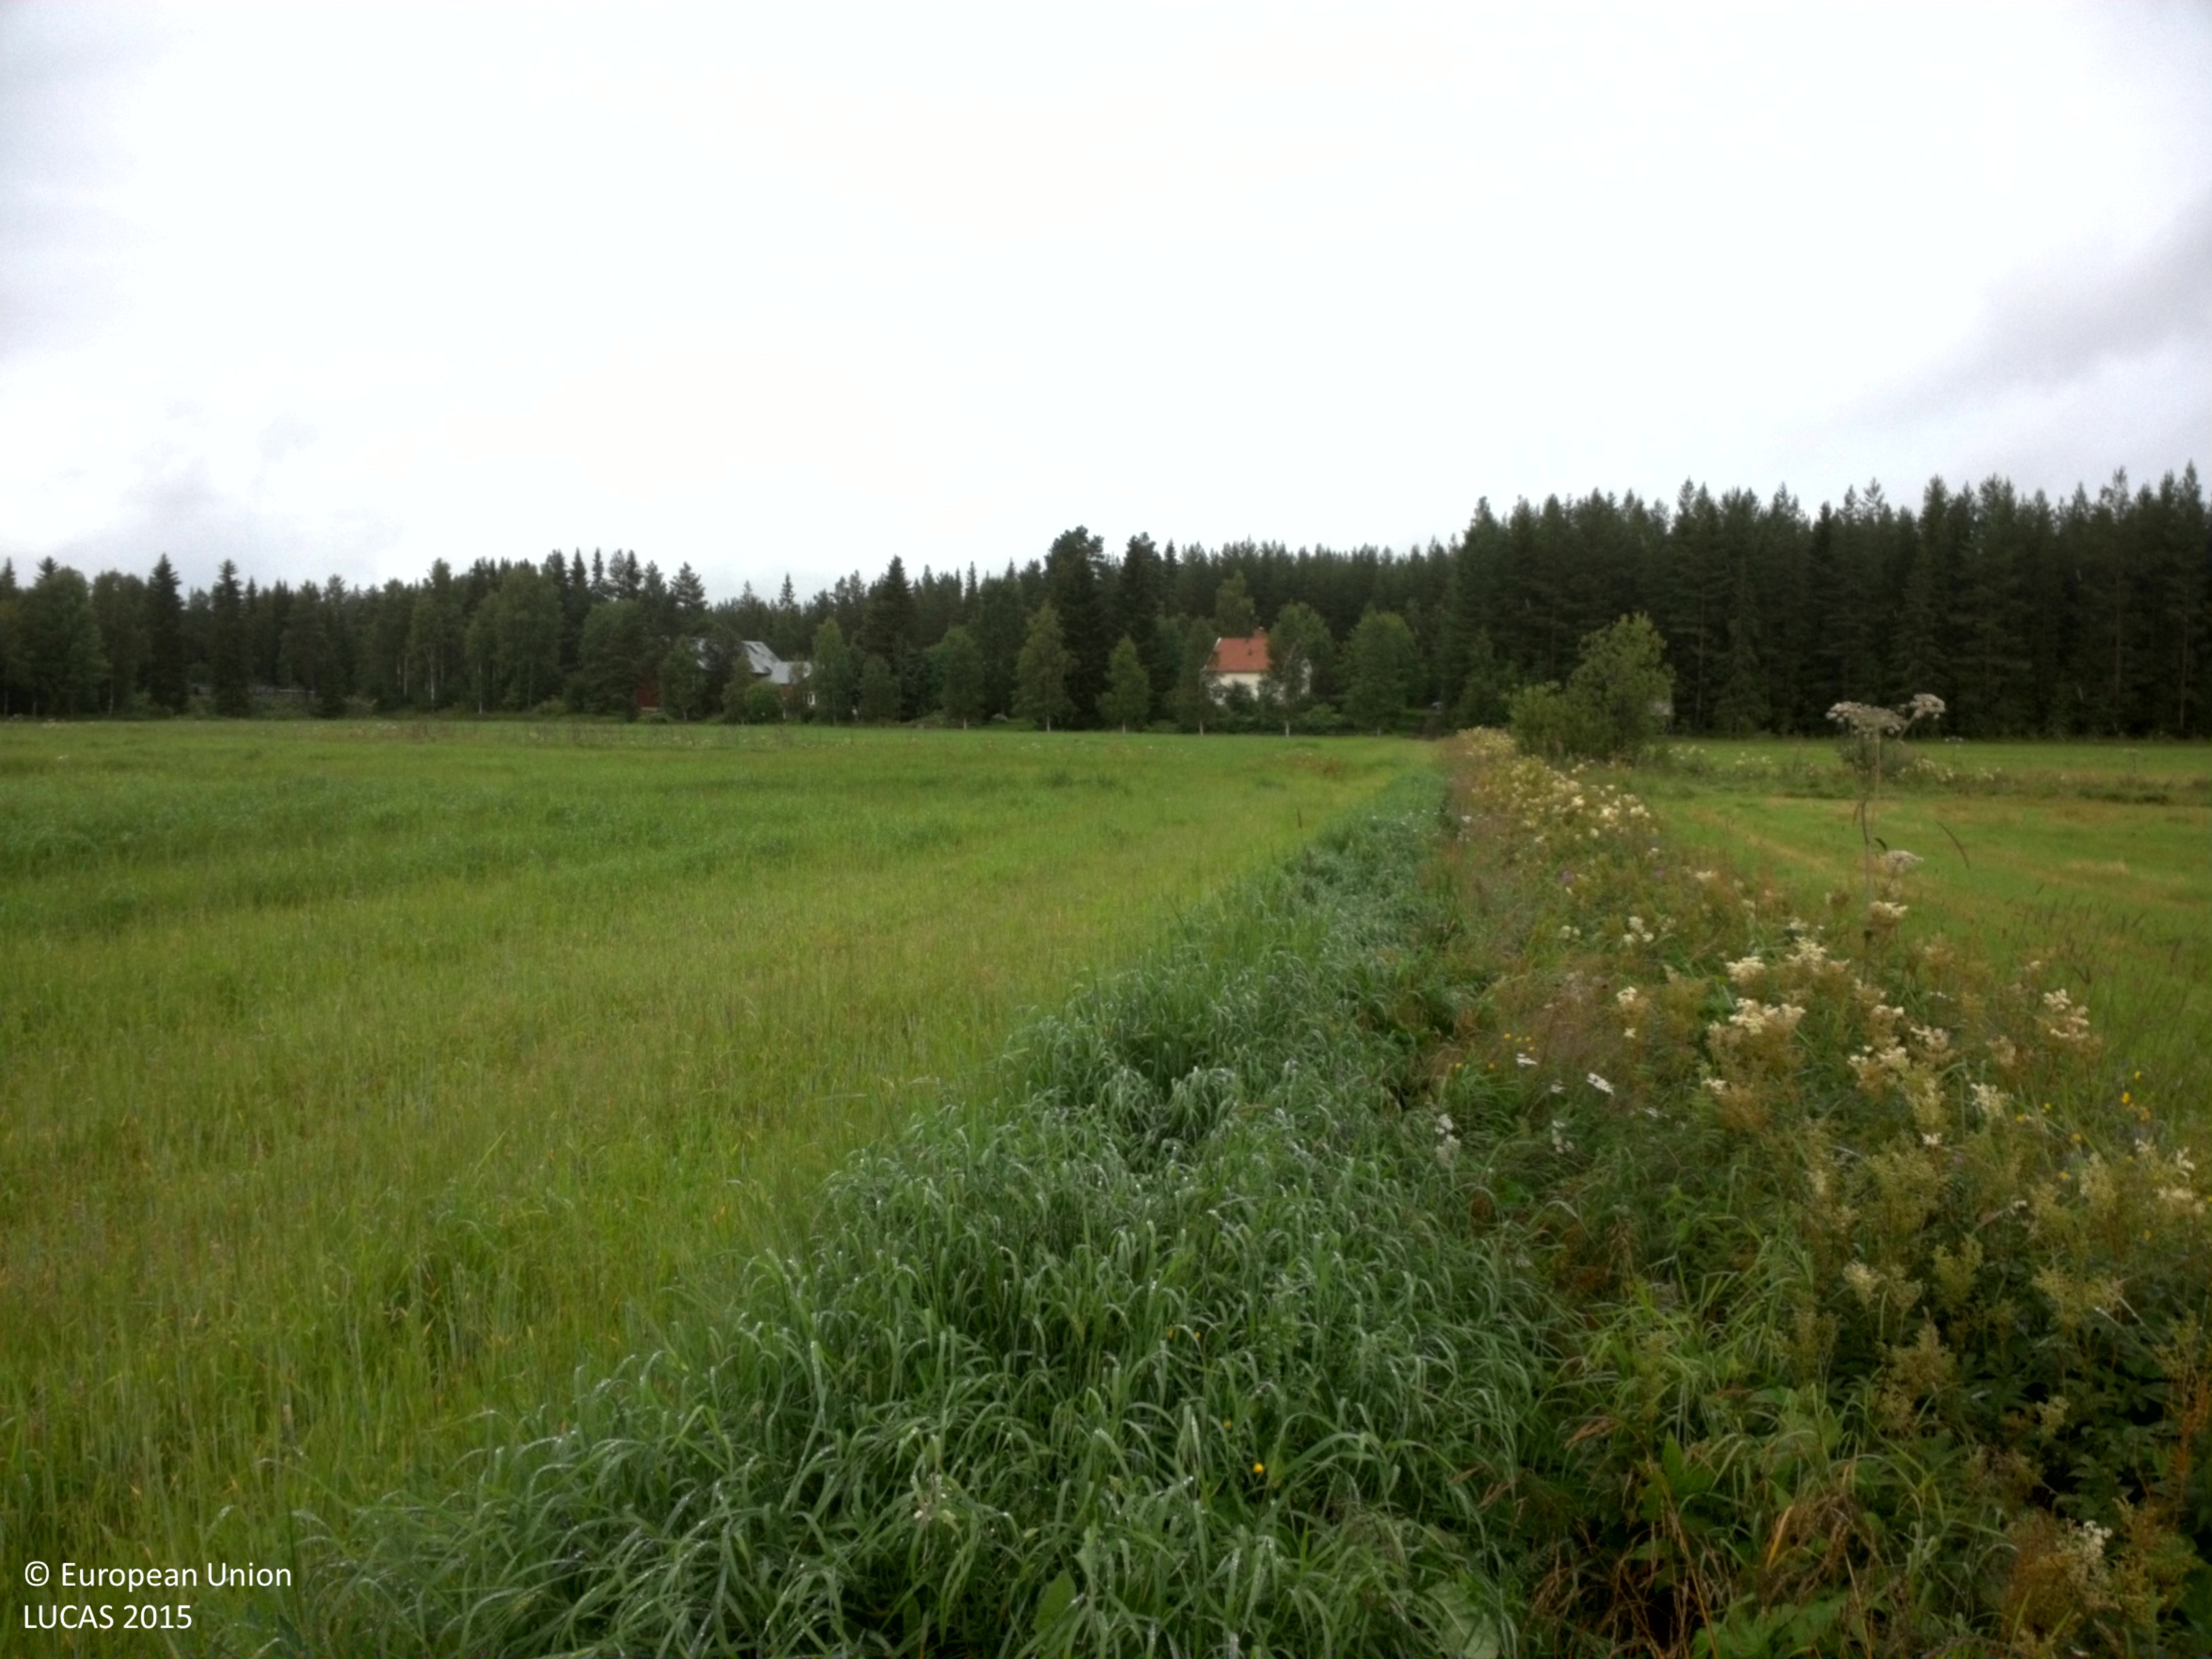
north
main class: Cropland
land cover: Barley
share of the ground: > 75 %
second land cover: Rye
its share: 25 - 50 %
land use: Agriculture (excluding fallow land and kitchen gardens)
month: August
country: SE
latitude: 64.6563
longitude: 20.9716
